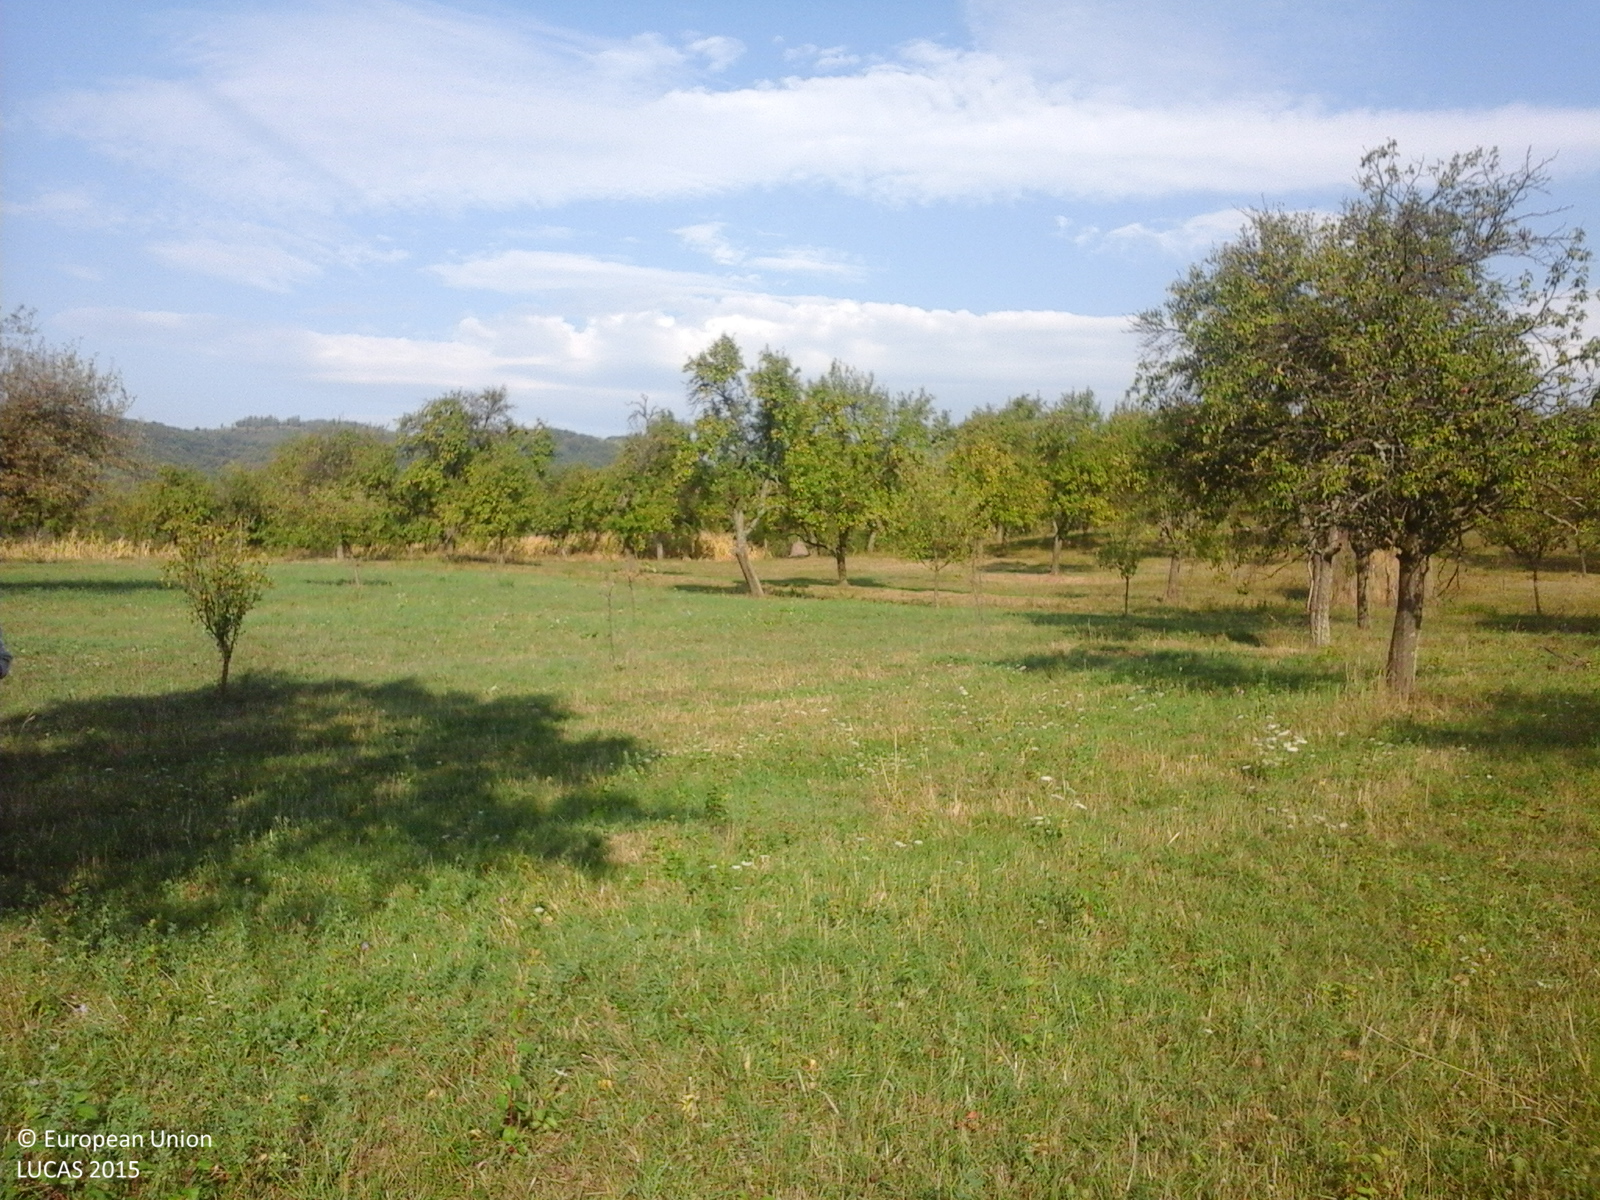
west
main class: Cropland
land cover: Other fruit trees and berries
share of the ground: 50 - 75 %
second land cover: Grassland without tree/shrub cover
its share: > 75 %
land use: Agriculture (excluding fallow land and kitchen gardens)
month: September
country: RO
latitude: 45.0946
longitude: 22.2762
